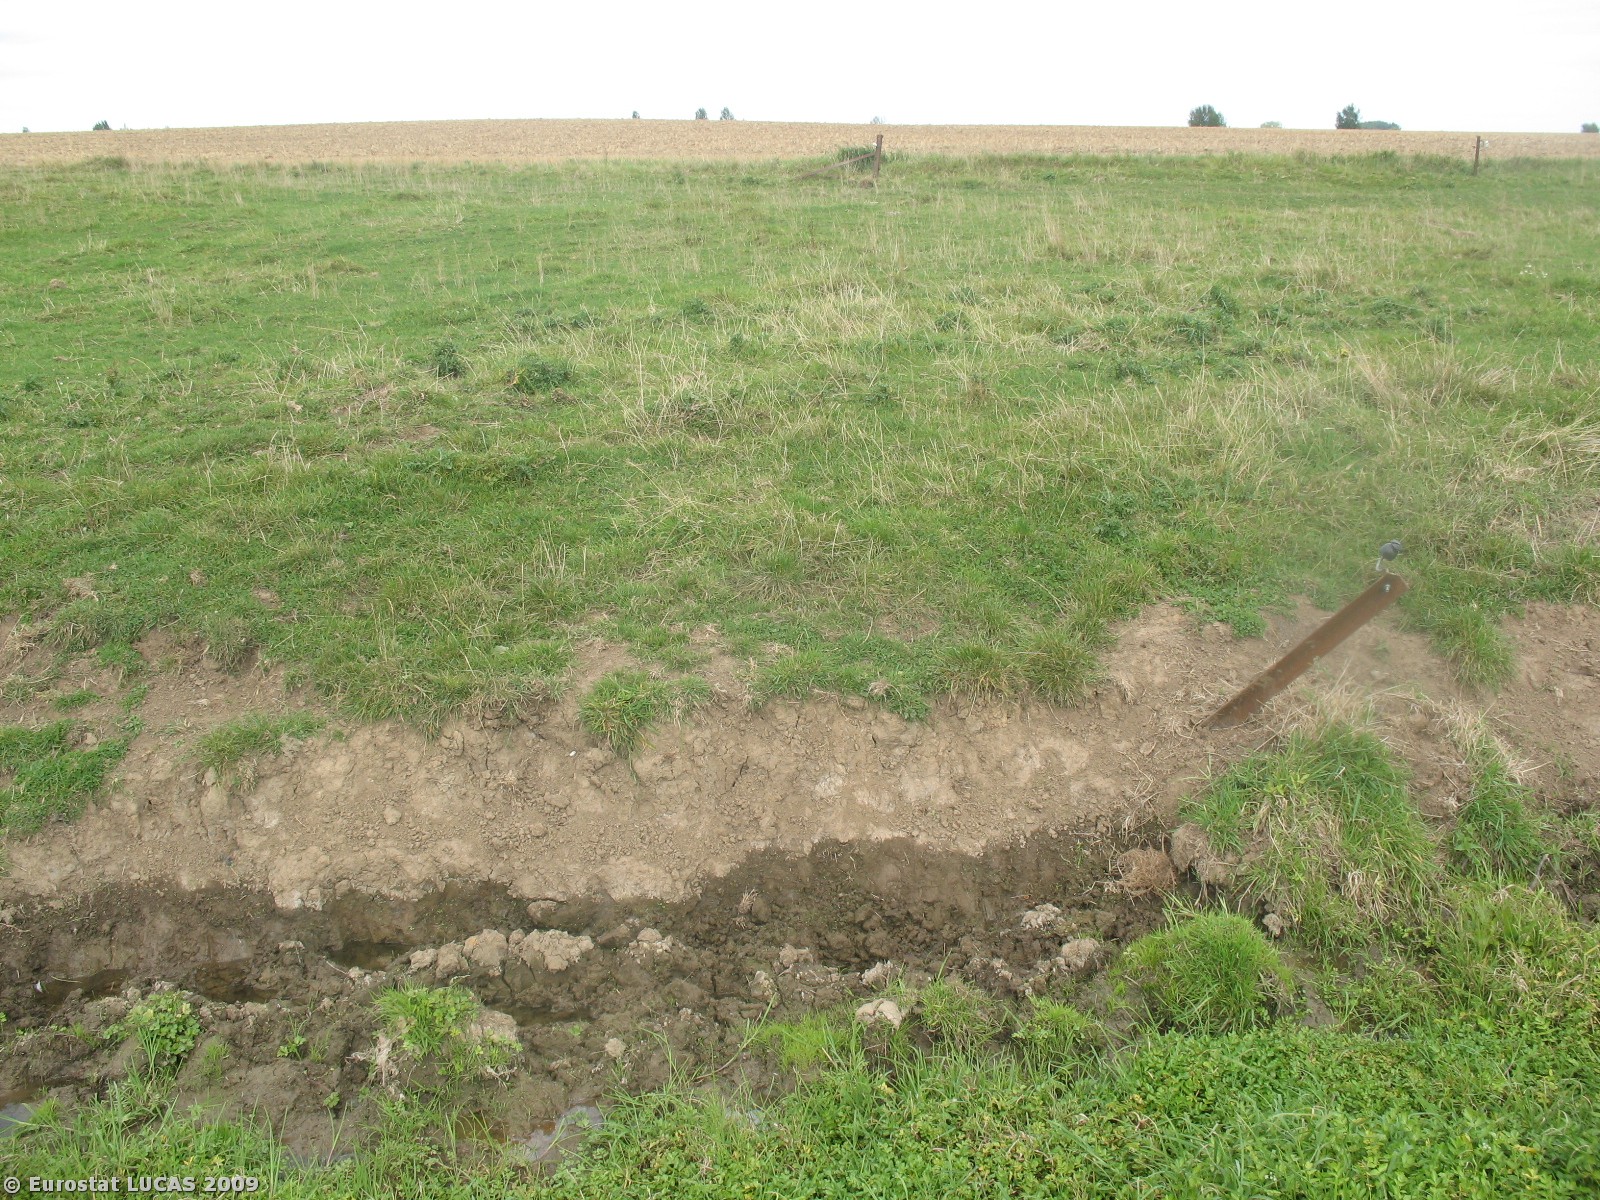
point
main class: Grassland
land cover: Grassland without tree/shrub cover
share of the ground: > 75 %
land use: Agriculture (excluding fallow land and kitchen gardens)
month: September
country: BE
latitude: 50.3563
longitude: 4.1053
